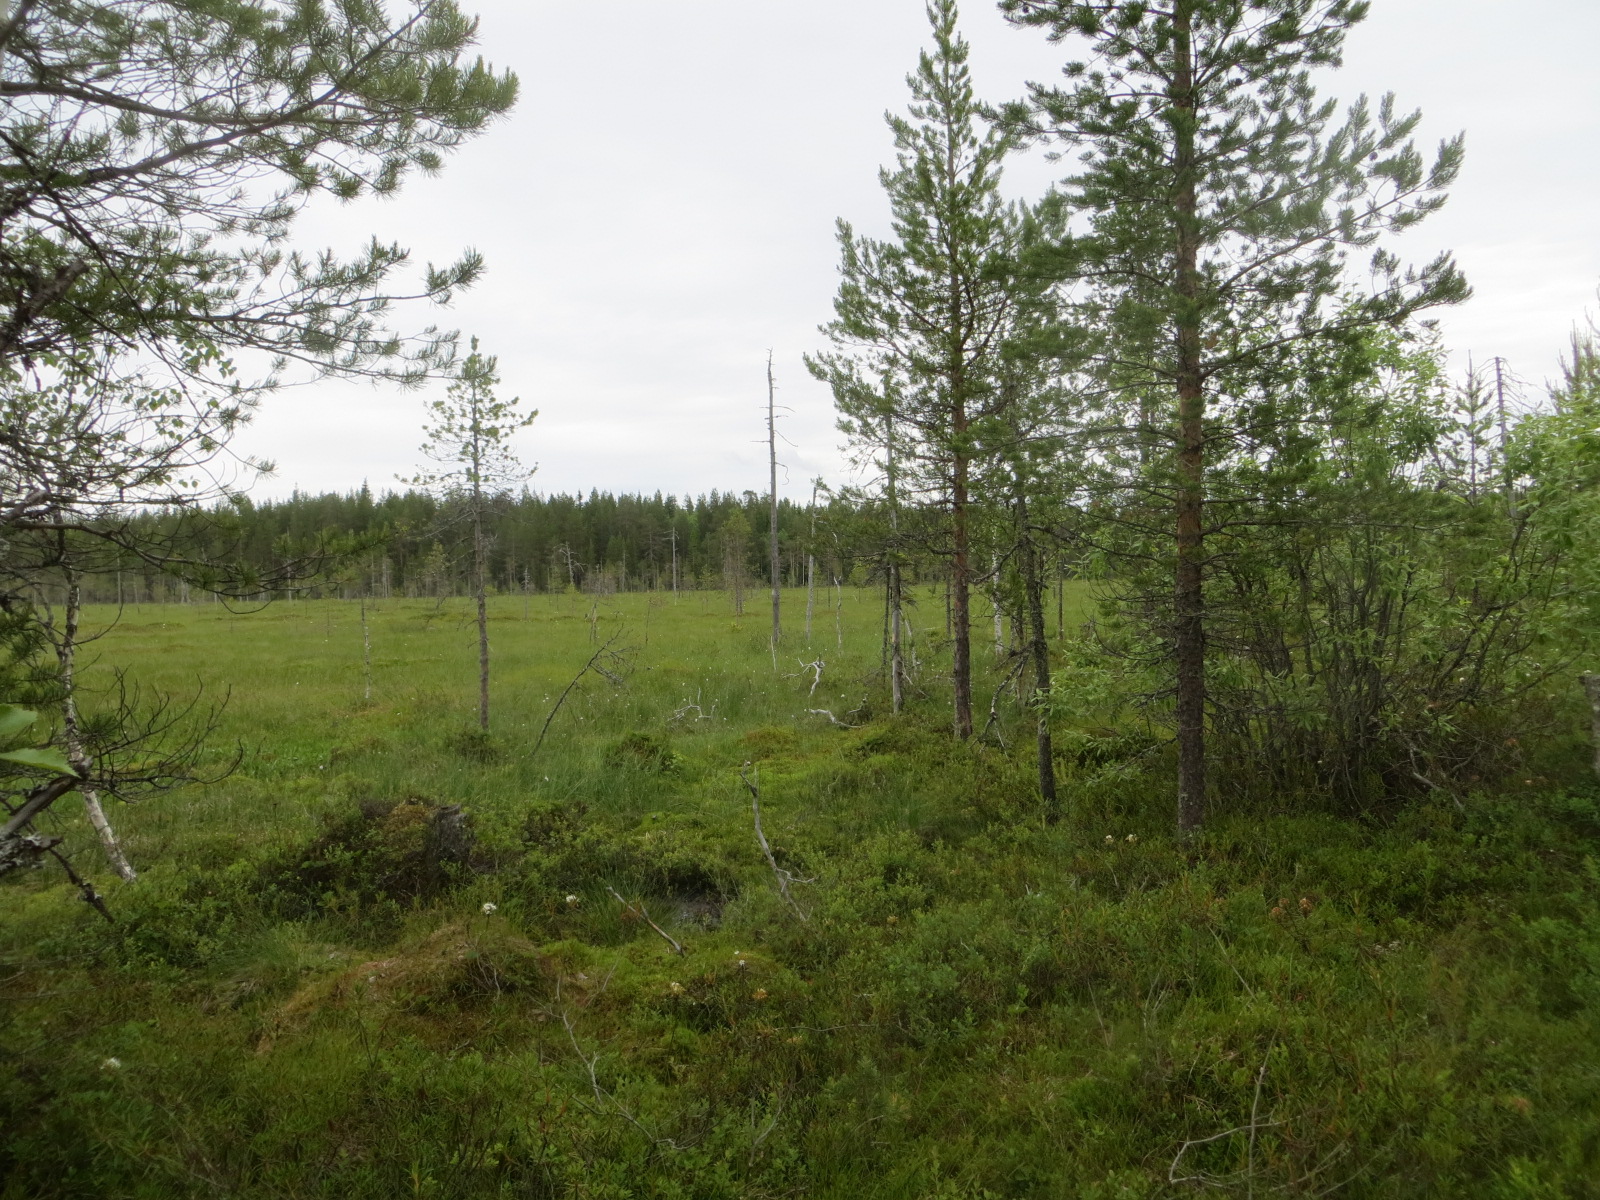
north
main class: Woodland
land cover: Pine dominated coniferous woodland
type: boreal forest
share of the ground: > 75 %
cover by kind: coniferous forest trees 75 %, shrubs 20 %, broadleaved forest trees 5 %
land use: Forestry
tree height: > 5 m
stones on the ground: 25 - 50 %
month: July
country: FI
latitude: 65.5765
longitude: 25.8416
